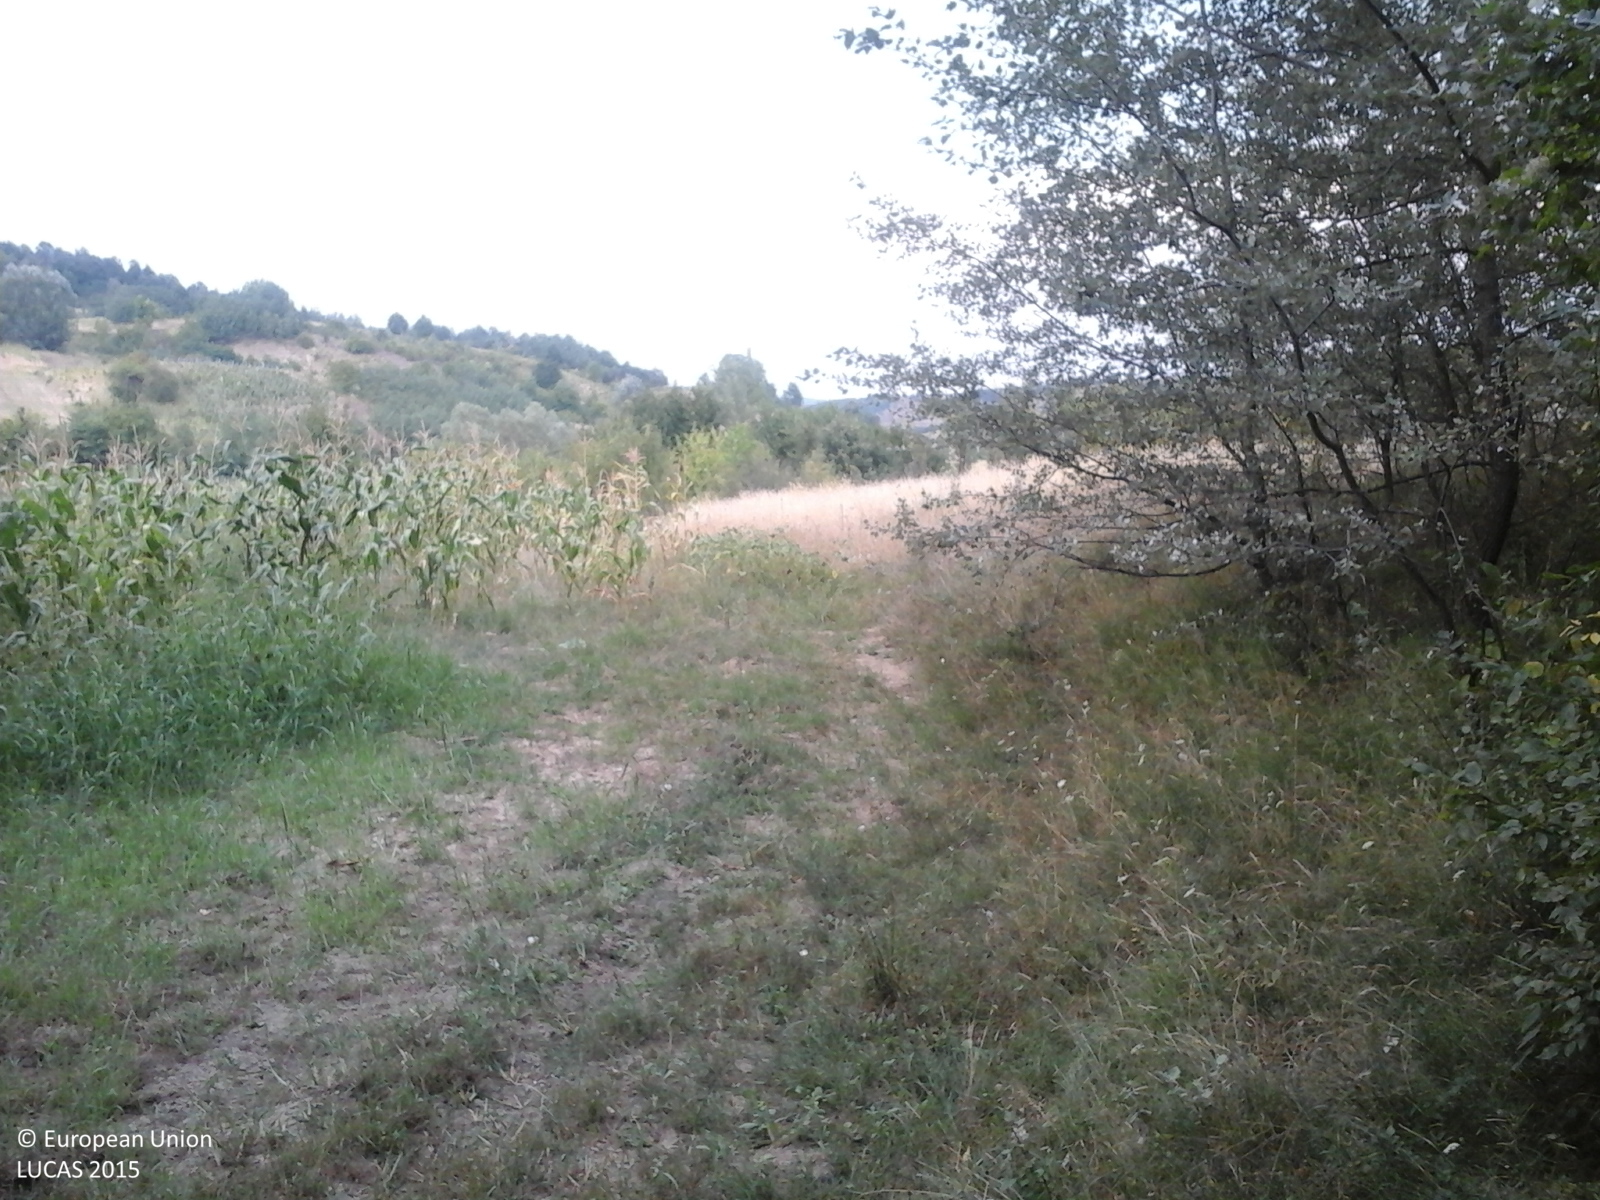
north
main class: Woodland
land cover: Broadleaved woodland
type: beech forest
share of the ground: > 75 %
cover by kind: broadleaved forest trees 80 %, herbaceous plants 20 %
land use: Forestry
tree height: > 5 m
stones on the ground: < 10 %
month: August
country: RO
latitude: 44.6509
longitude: 23.0734
